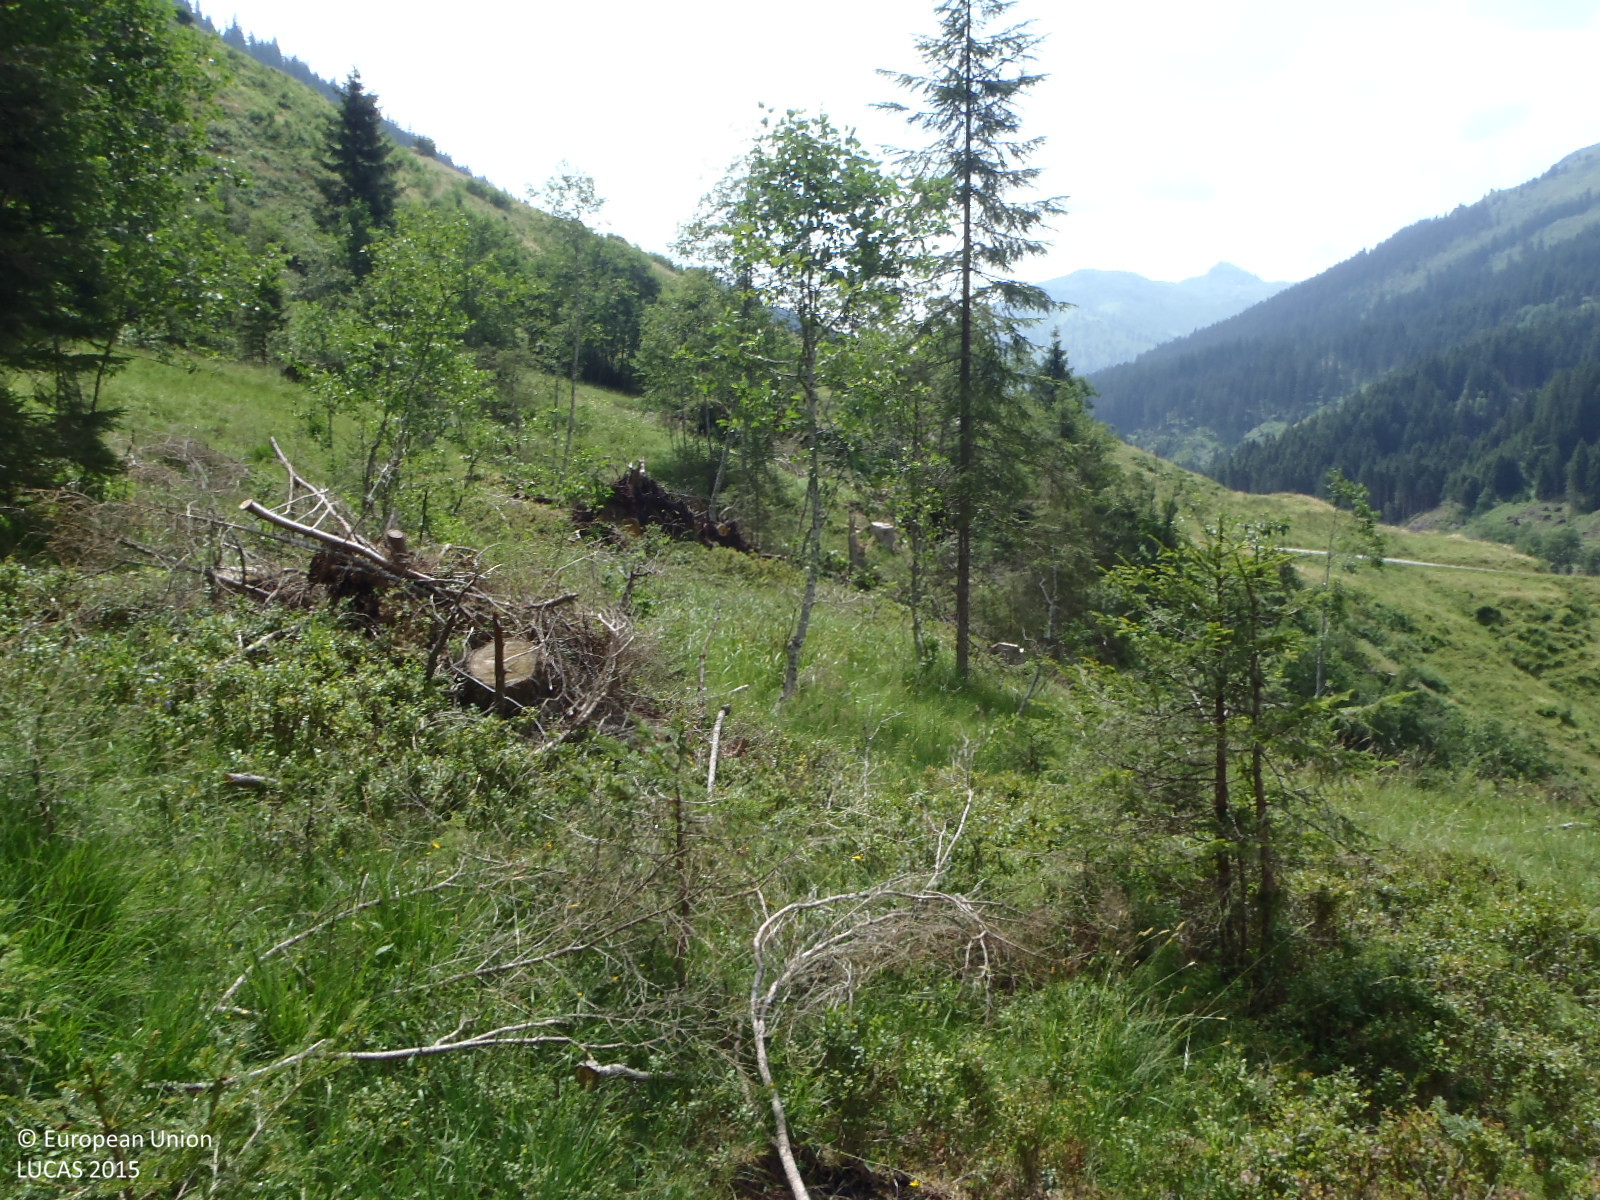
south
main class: Woodland
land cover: Spruce dominated mixed woodland
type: alpine coniferous forest
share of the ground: > 75 %
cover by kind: coniferous forest trees 50 %, broadleaved forest trees 25 %, herbaceous plants 25 %
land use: Forestry
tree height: > 5 m
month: July
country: AT
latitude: 47.2910
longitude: 11.7836
